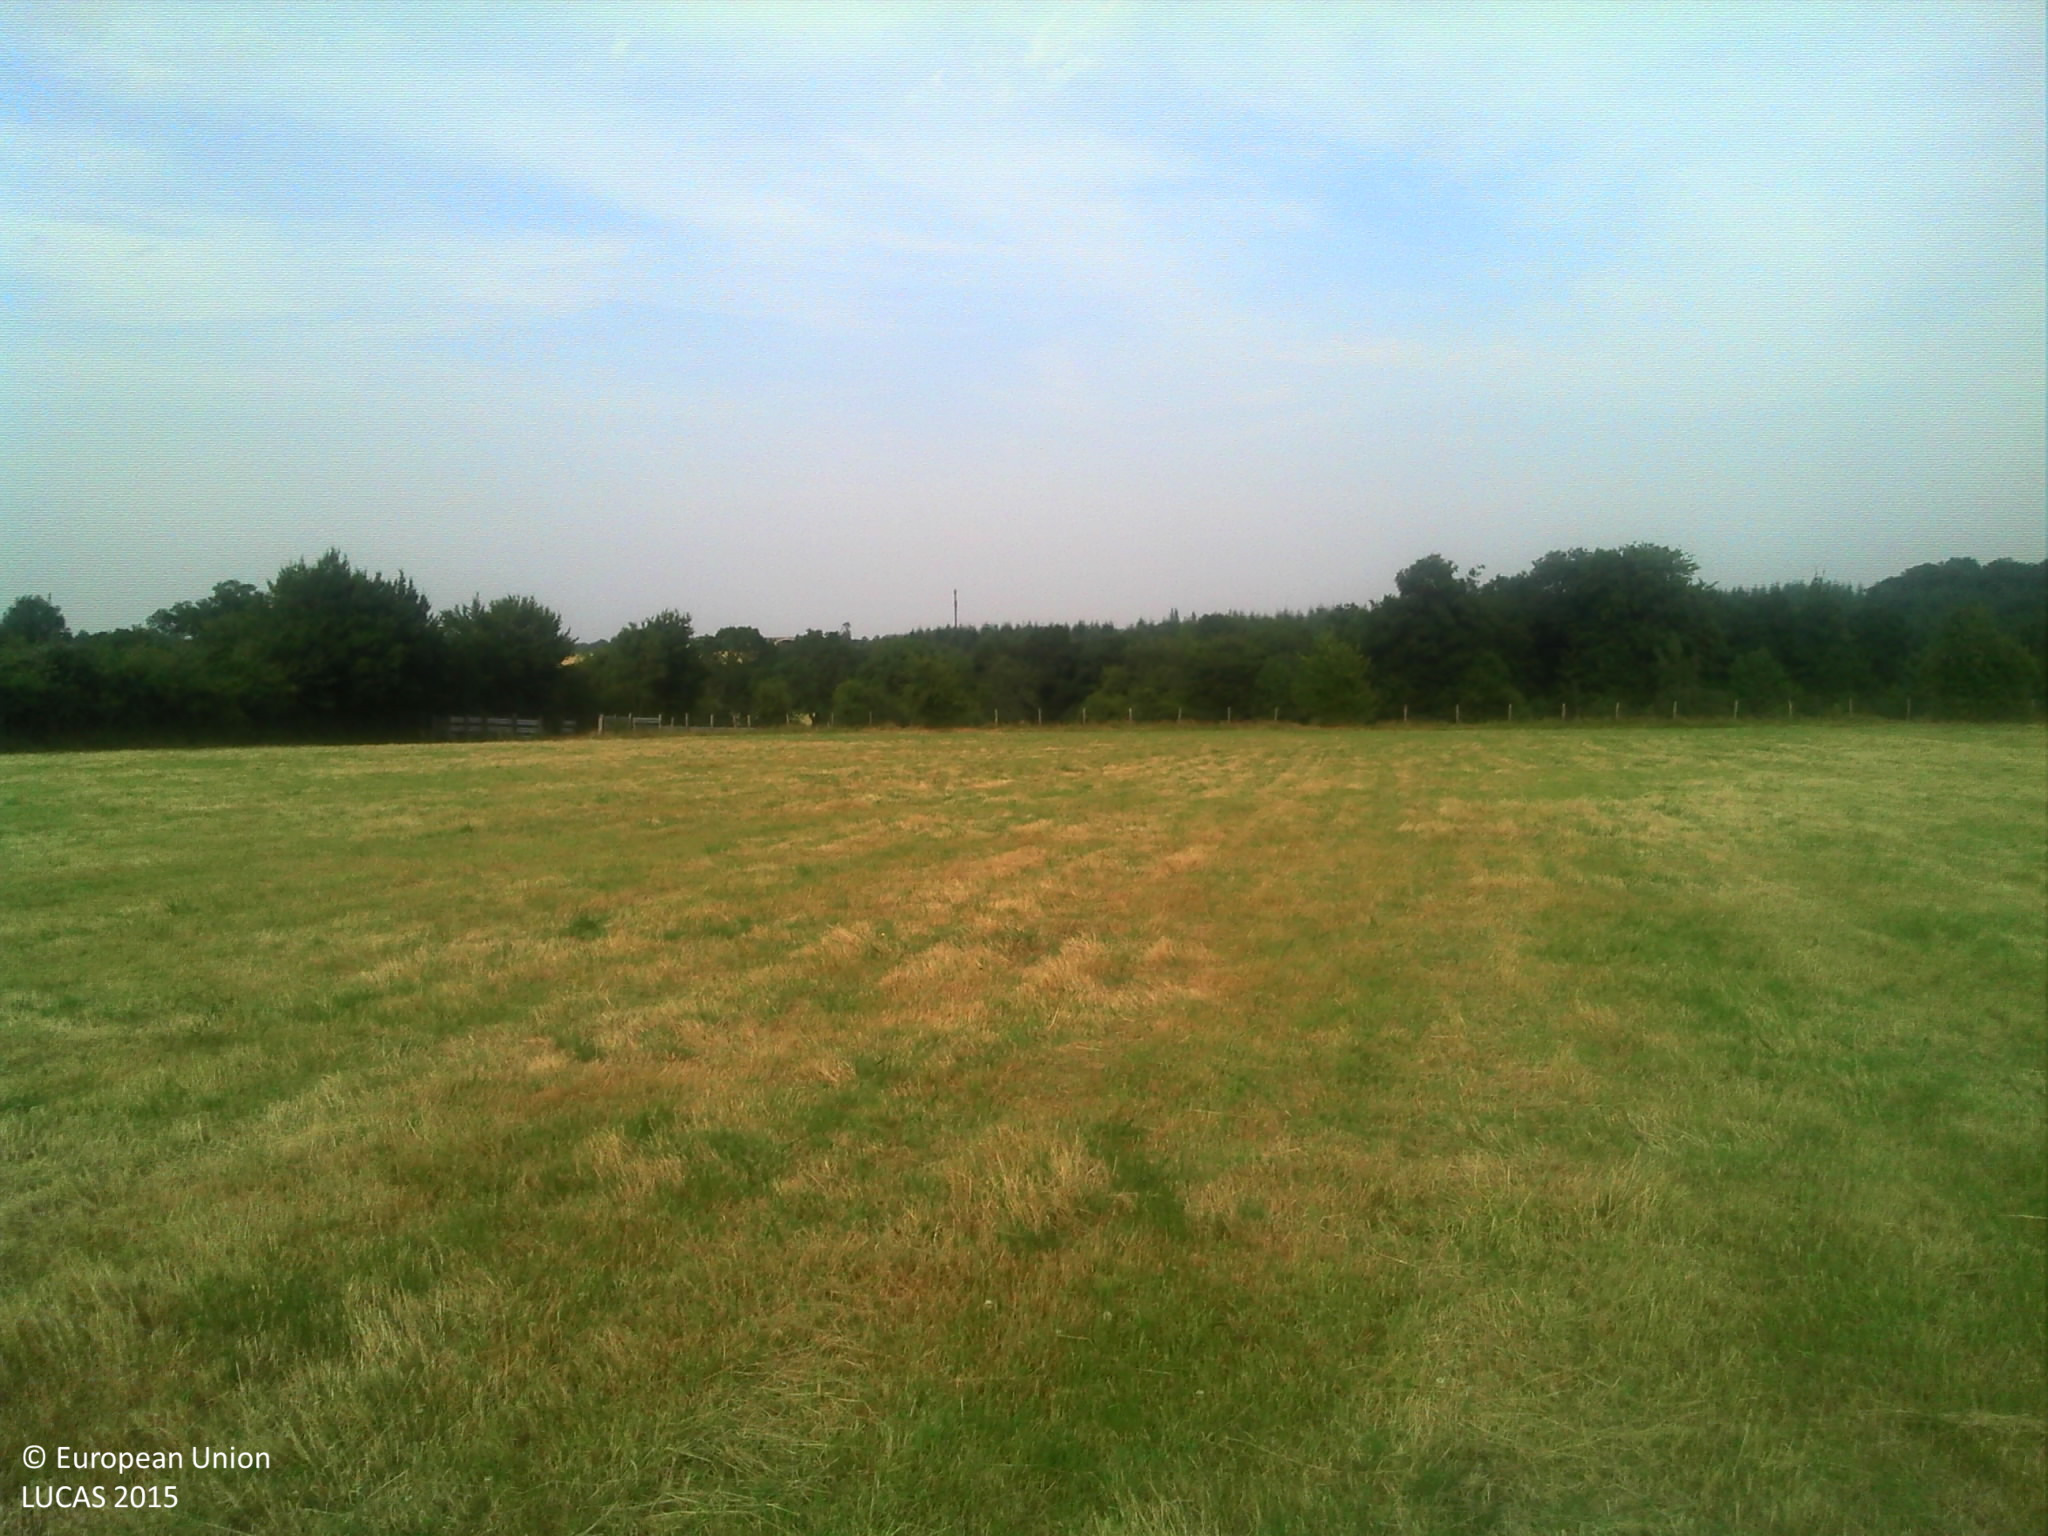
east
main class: Grassland
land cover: Grassland without tree/shrub cover
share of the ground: > 75 %
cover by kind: herbaceous plants 100 %
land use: Agriculture (excluding fallow land and kitchen gardens)
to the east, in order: Grassland without tree/shrub cover; Fences; Grassland without tree/shrub cover; Broadleaved woodland
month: July
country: FR
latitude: 48.9453
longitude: 0.4019
